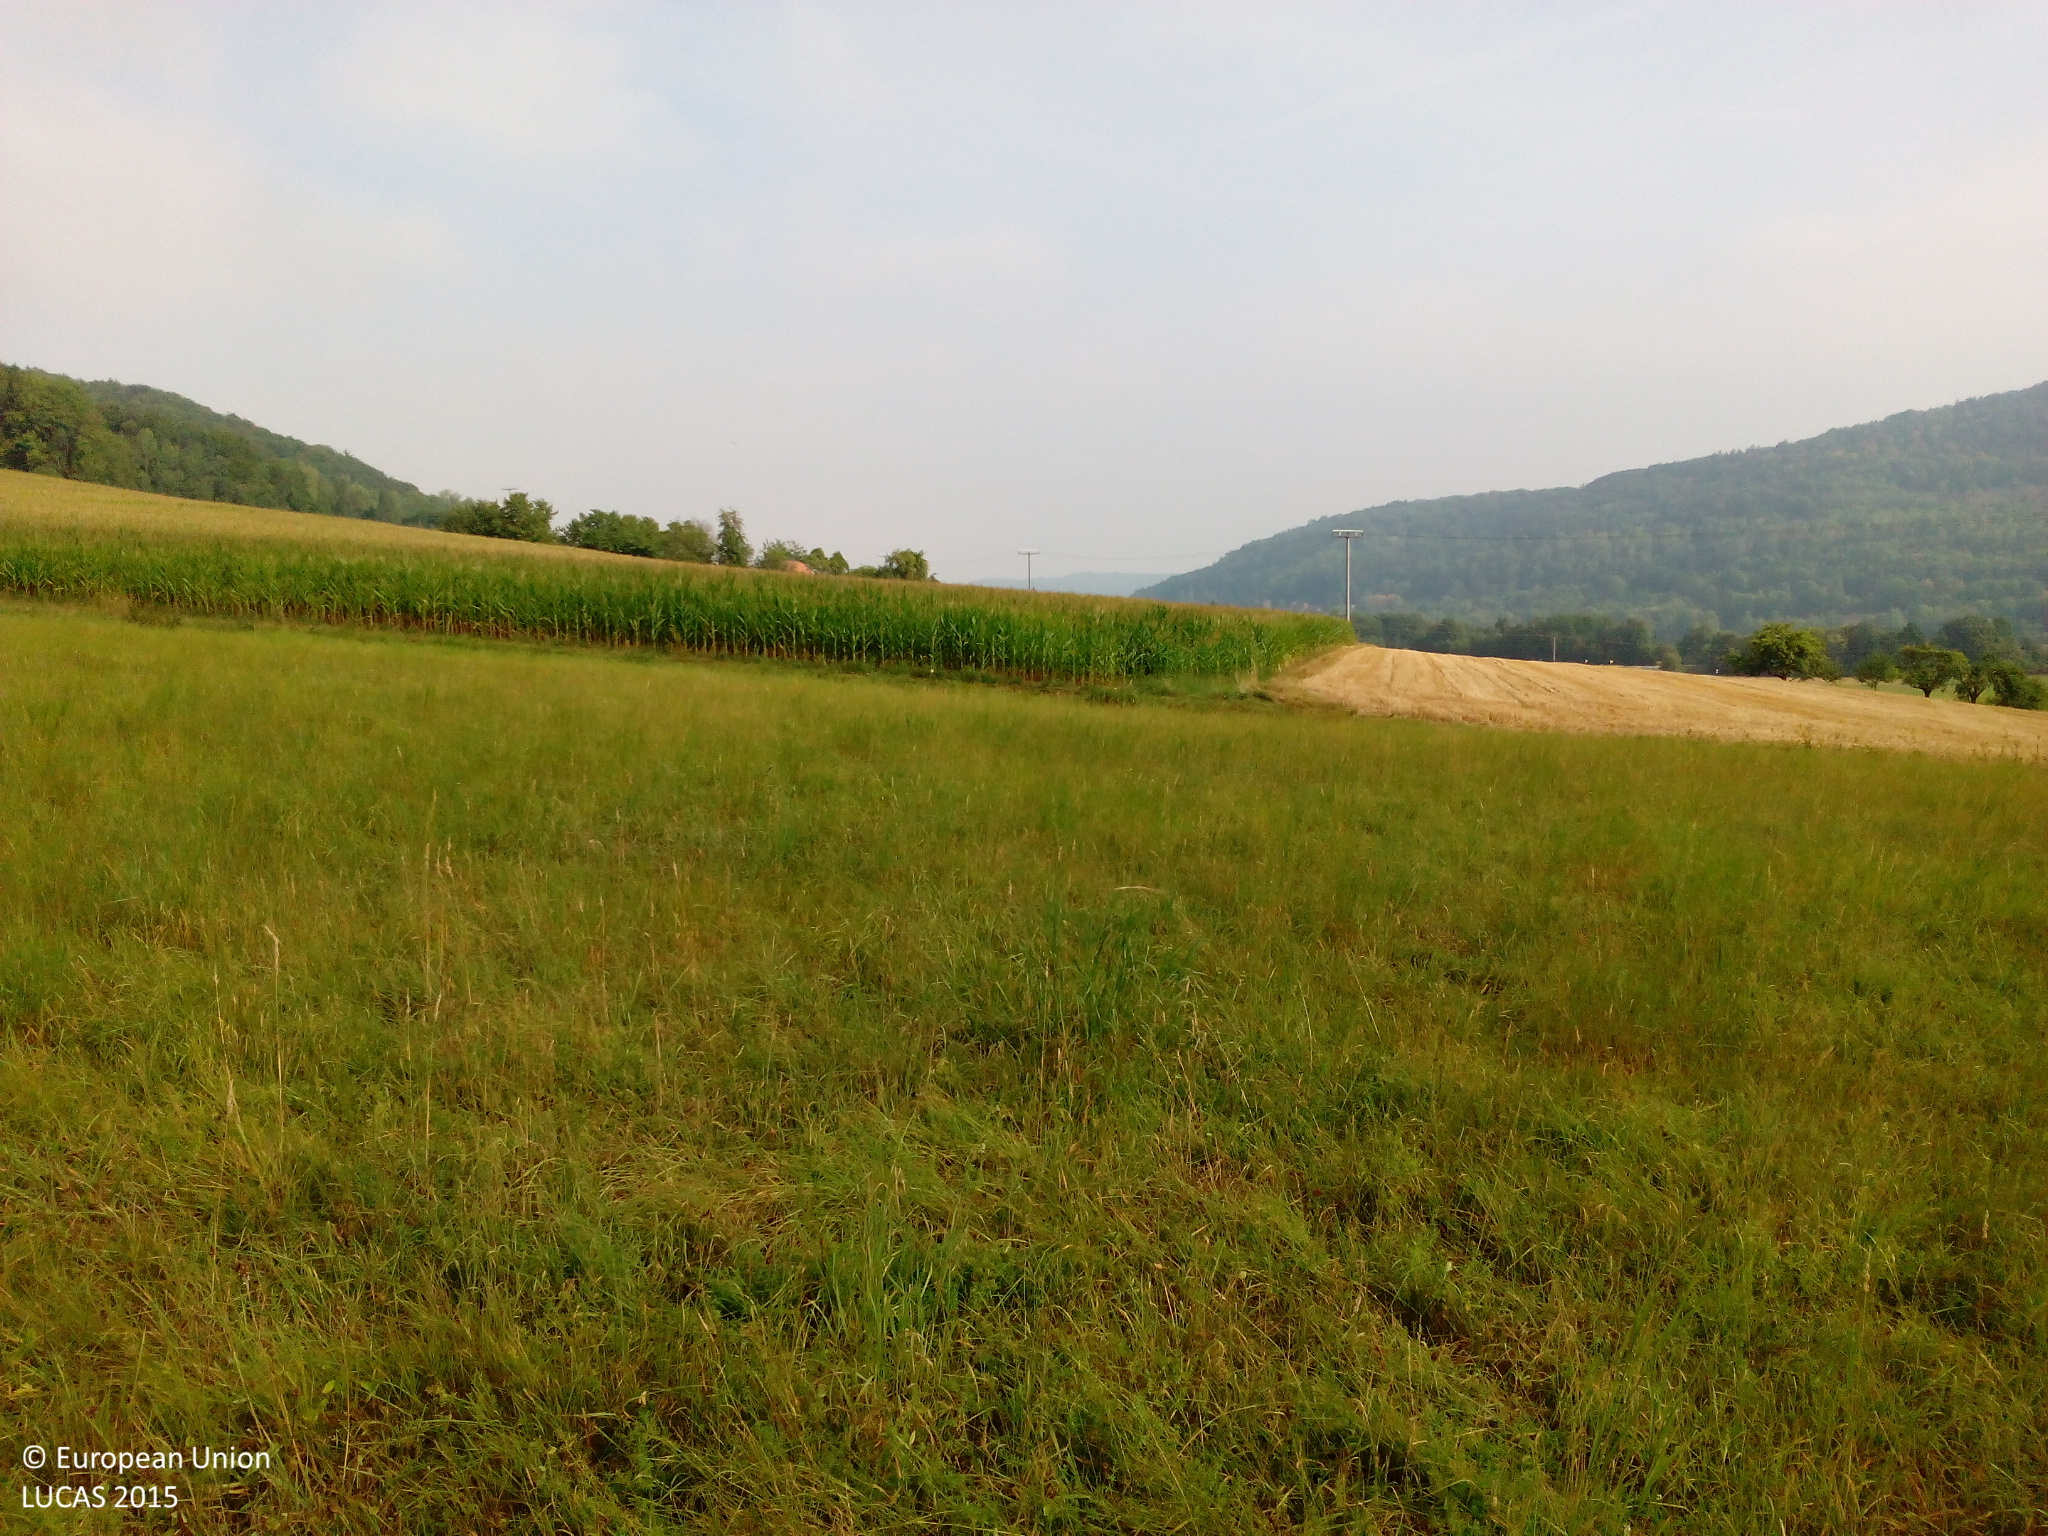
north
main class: Grassland
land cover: Grassland without tree/shrub cover
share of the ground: > 75 %
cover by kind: herbaceous plants 95 %
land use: Agriculture (excluding fallow land and kitchen gardens)
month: August
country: DE
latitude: 49.4732
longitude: 11.4762
